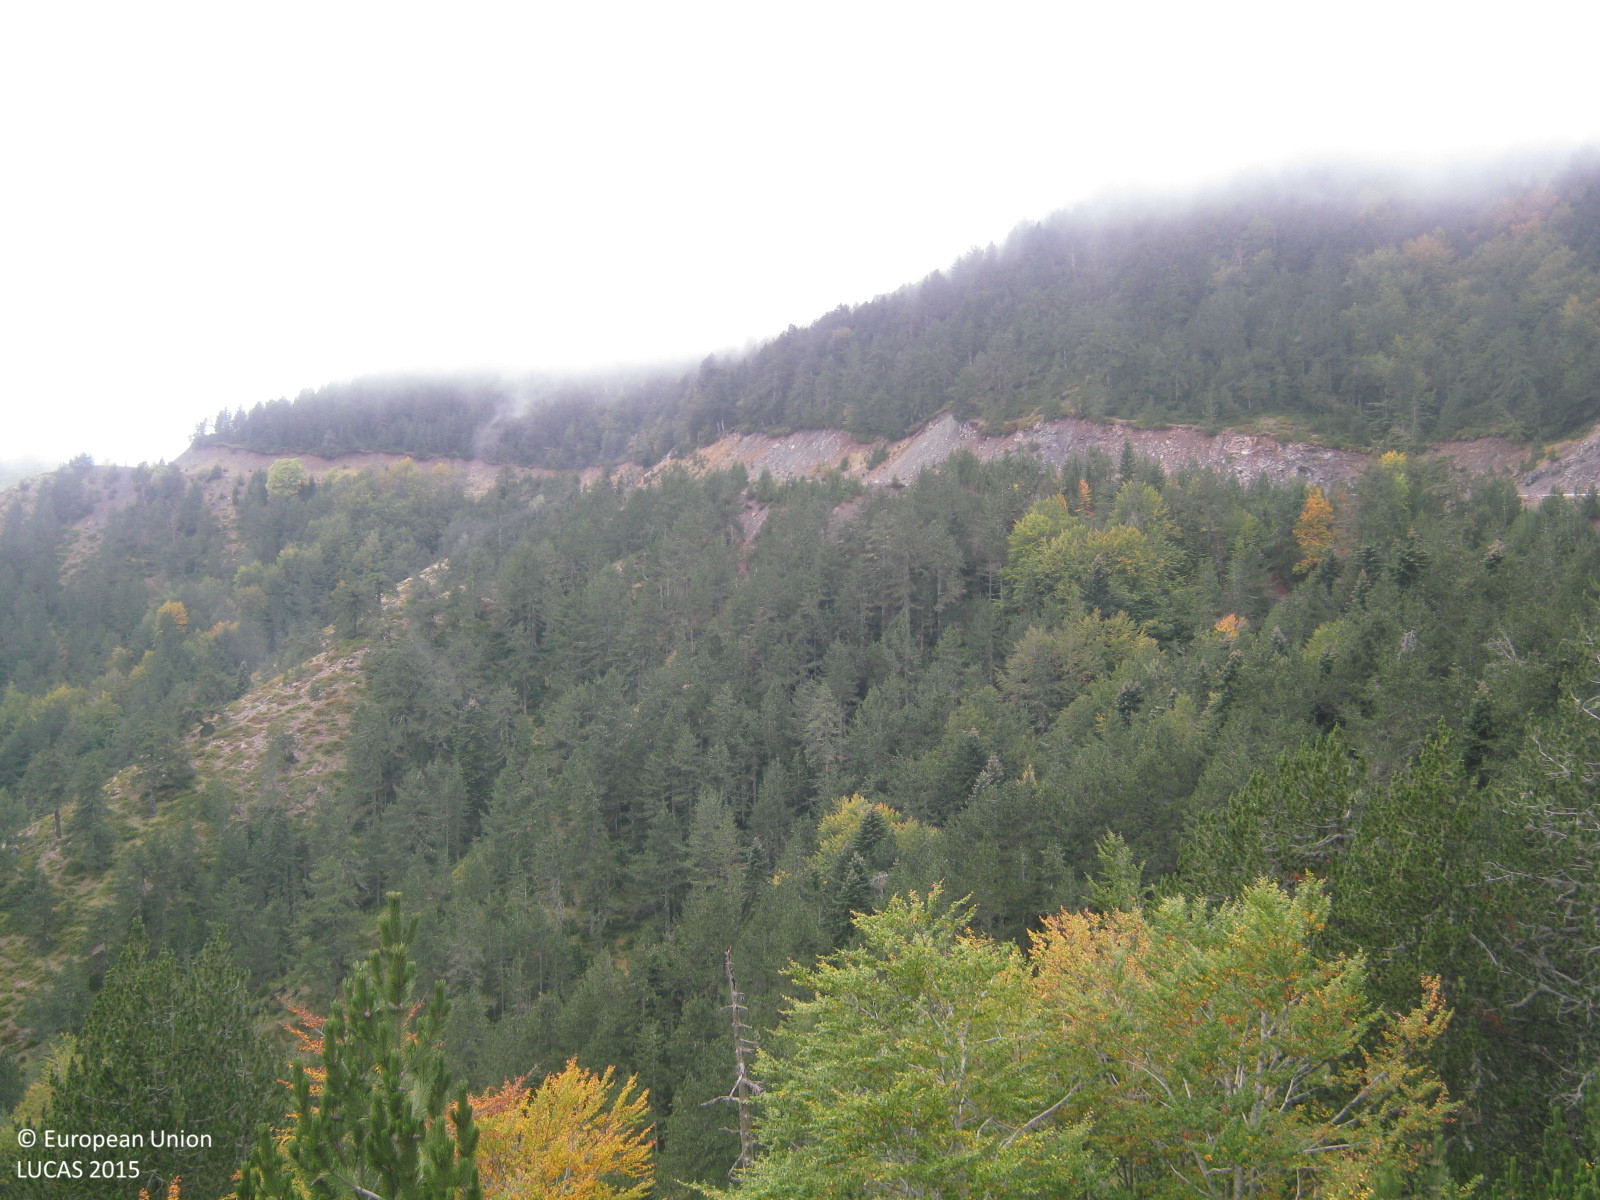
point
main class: Woodland
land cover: Spruce dominated mixed woodland
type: coniferous forest of the mediterranean region
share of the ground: > 75 %
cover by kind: coniferous forest trees 60 %, broadleaved forest trees 25 %, unconsolidated bare surface 10 %, herbaceous plants 5 %
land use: Semi-natural and natural areas not in use
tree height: > 5 m
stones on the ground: > 50 %
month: October
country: GR
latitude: 39.8030
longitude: 21.2299
